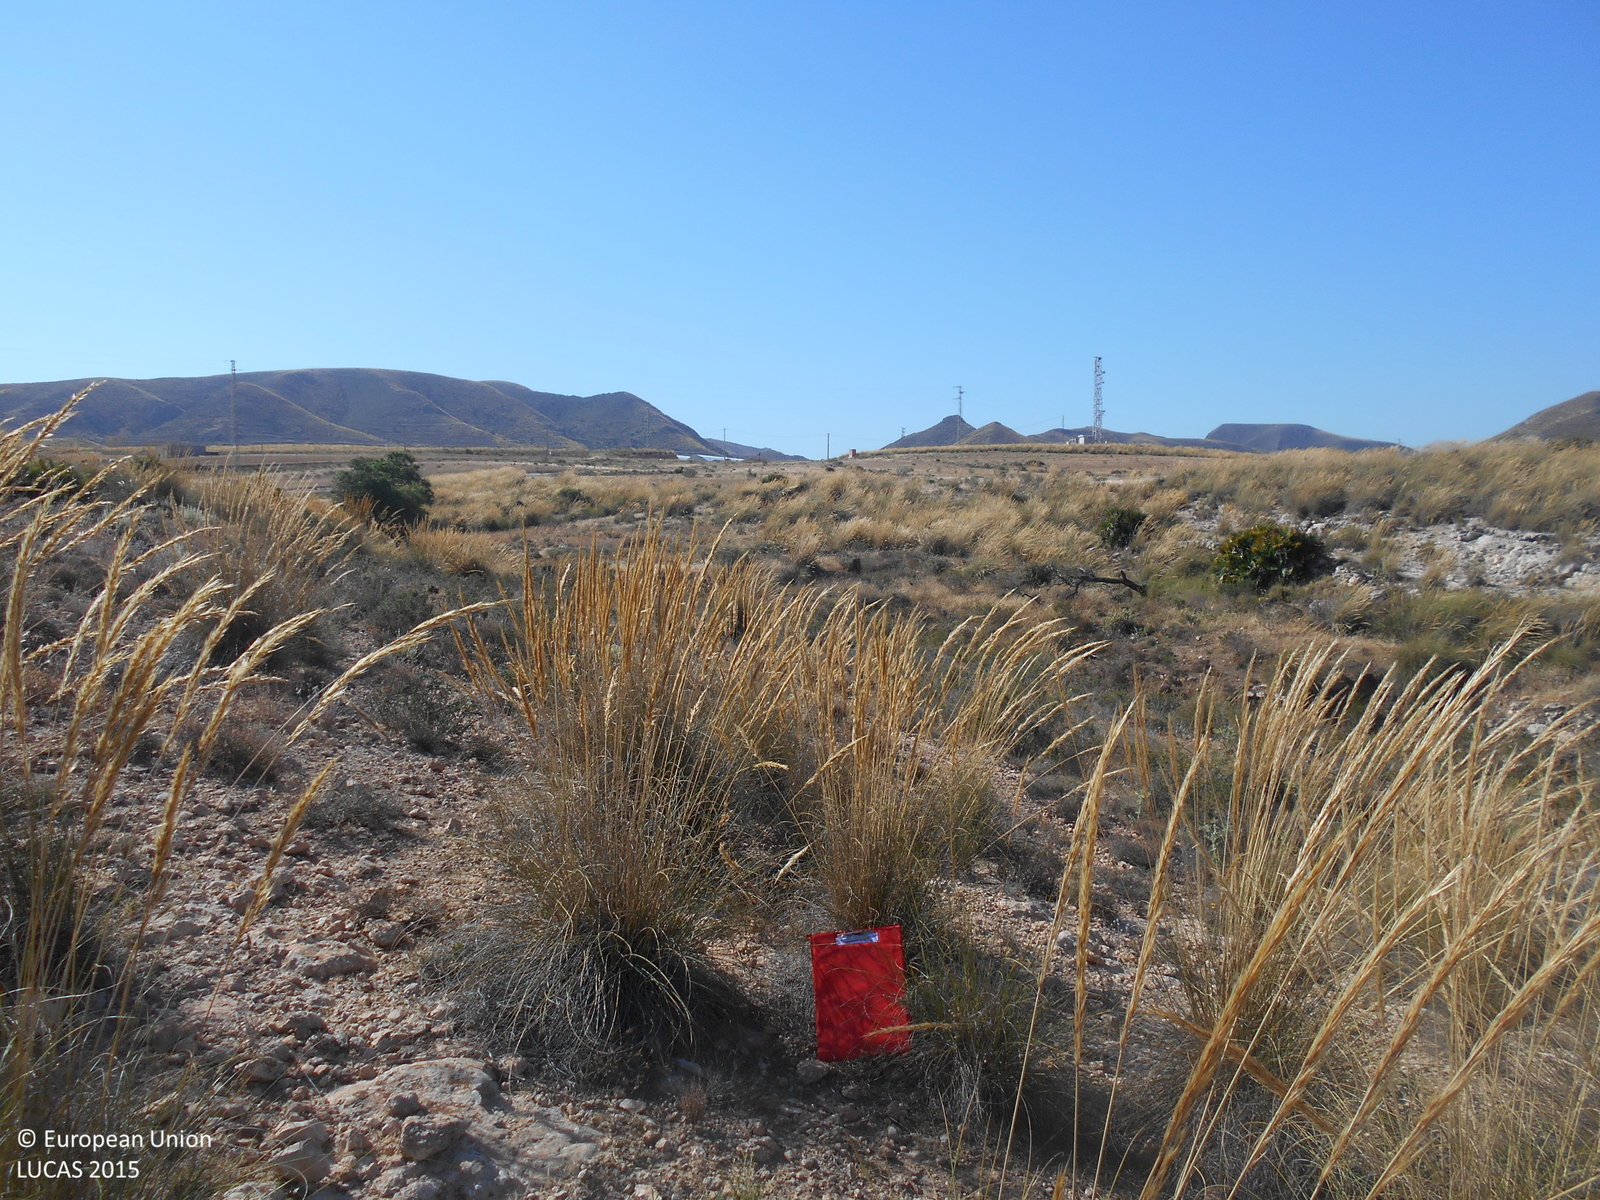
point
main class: Shrubland
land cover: Shrubland without tree cover
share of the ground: 25 - 50 %
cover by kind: shrubs 30 %, consolidated bare surface 30 %, unconsolidated bare surface 30 %, herbaceous plants 10 %
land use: Semi-natural and natural areas not in use
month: May
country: ES
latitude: 36.8592
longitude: -2.1208
